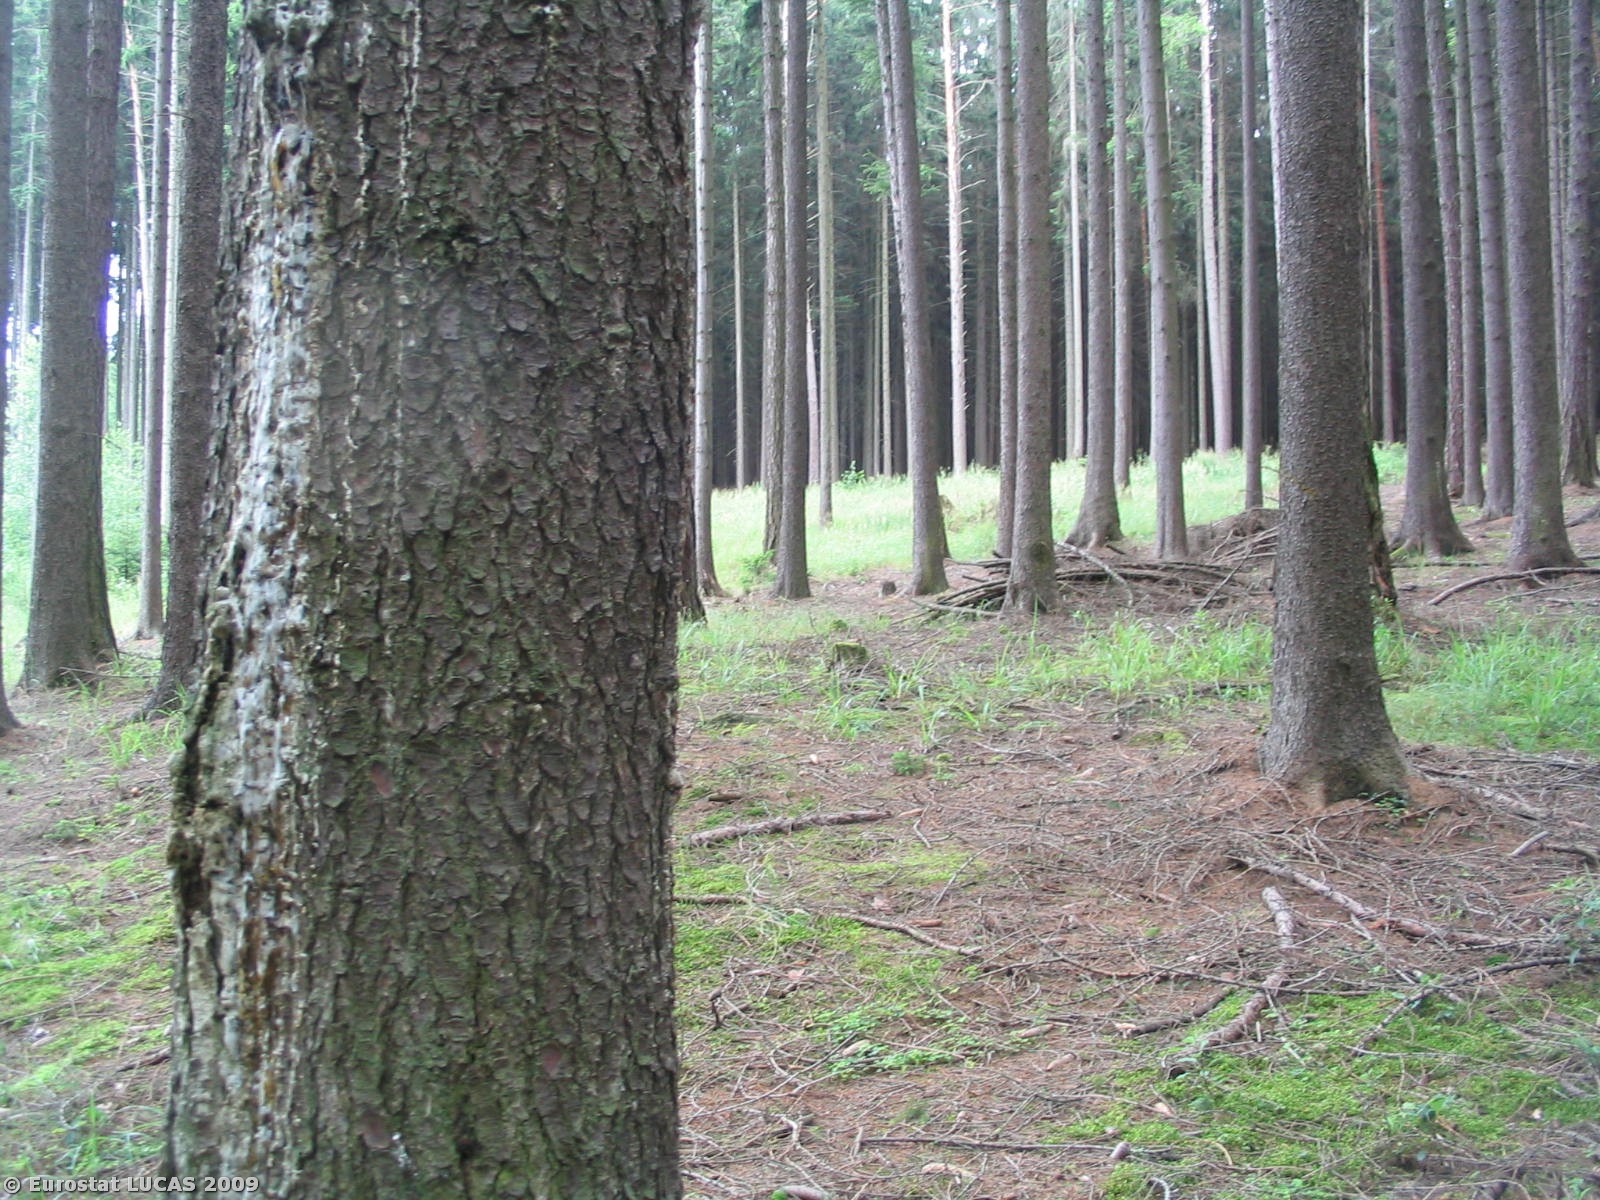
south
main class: Woodland
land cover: Coniferous woodland
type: hemiboreal forest and nemoral coniferous forest and mixed broadleaved-coniferous forest
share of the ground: > 75 %
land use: Forestry
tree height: > 5 m
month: July
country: CZ
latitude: 49.4051
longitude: 16.4704
